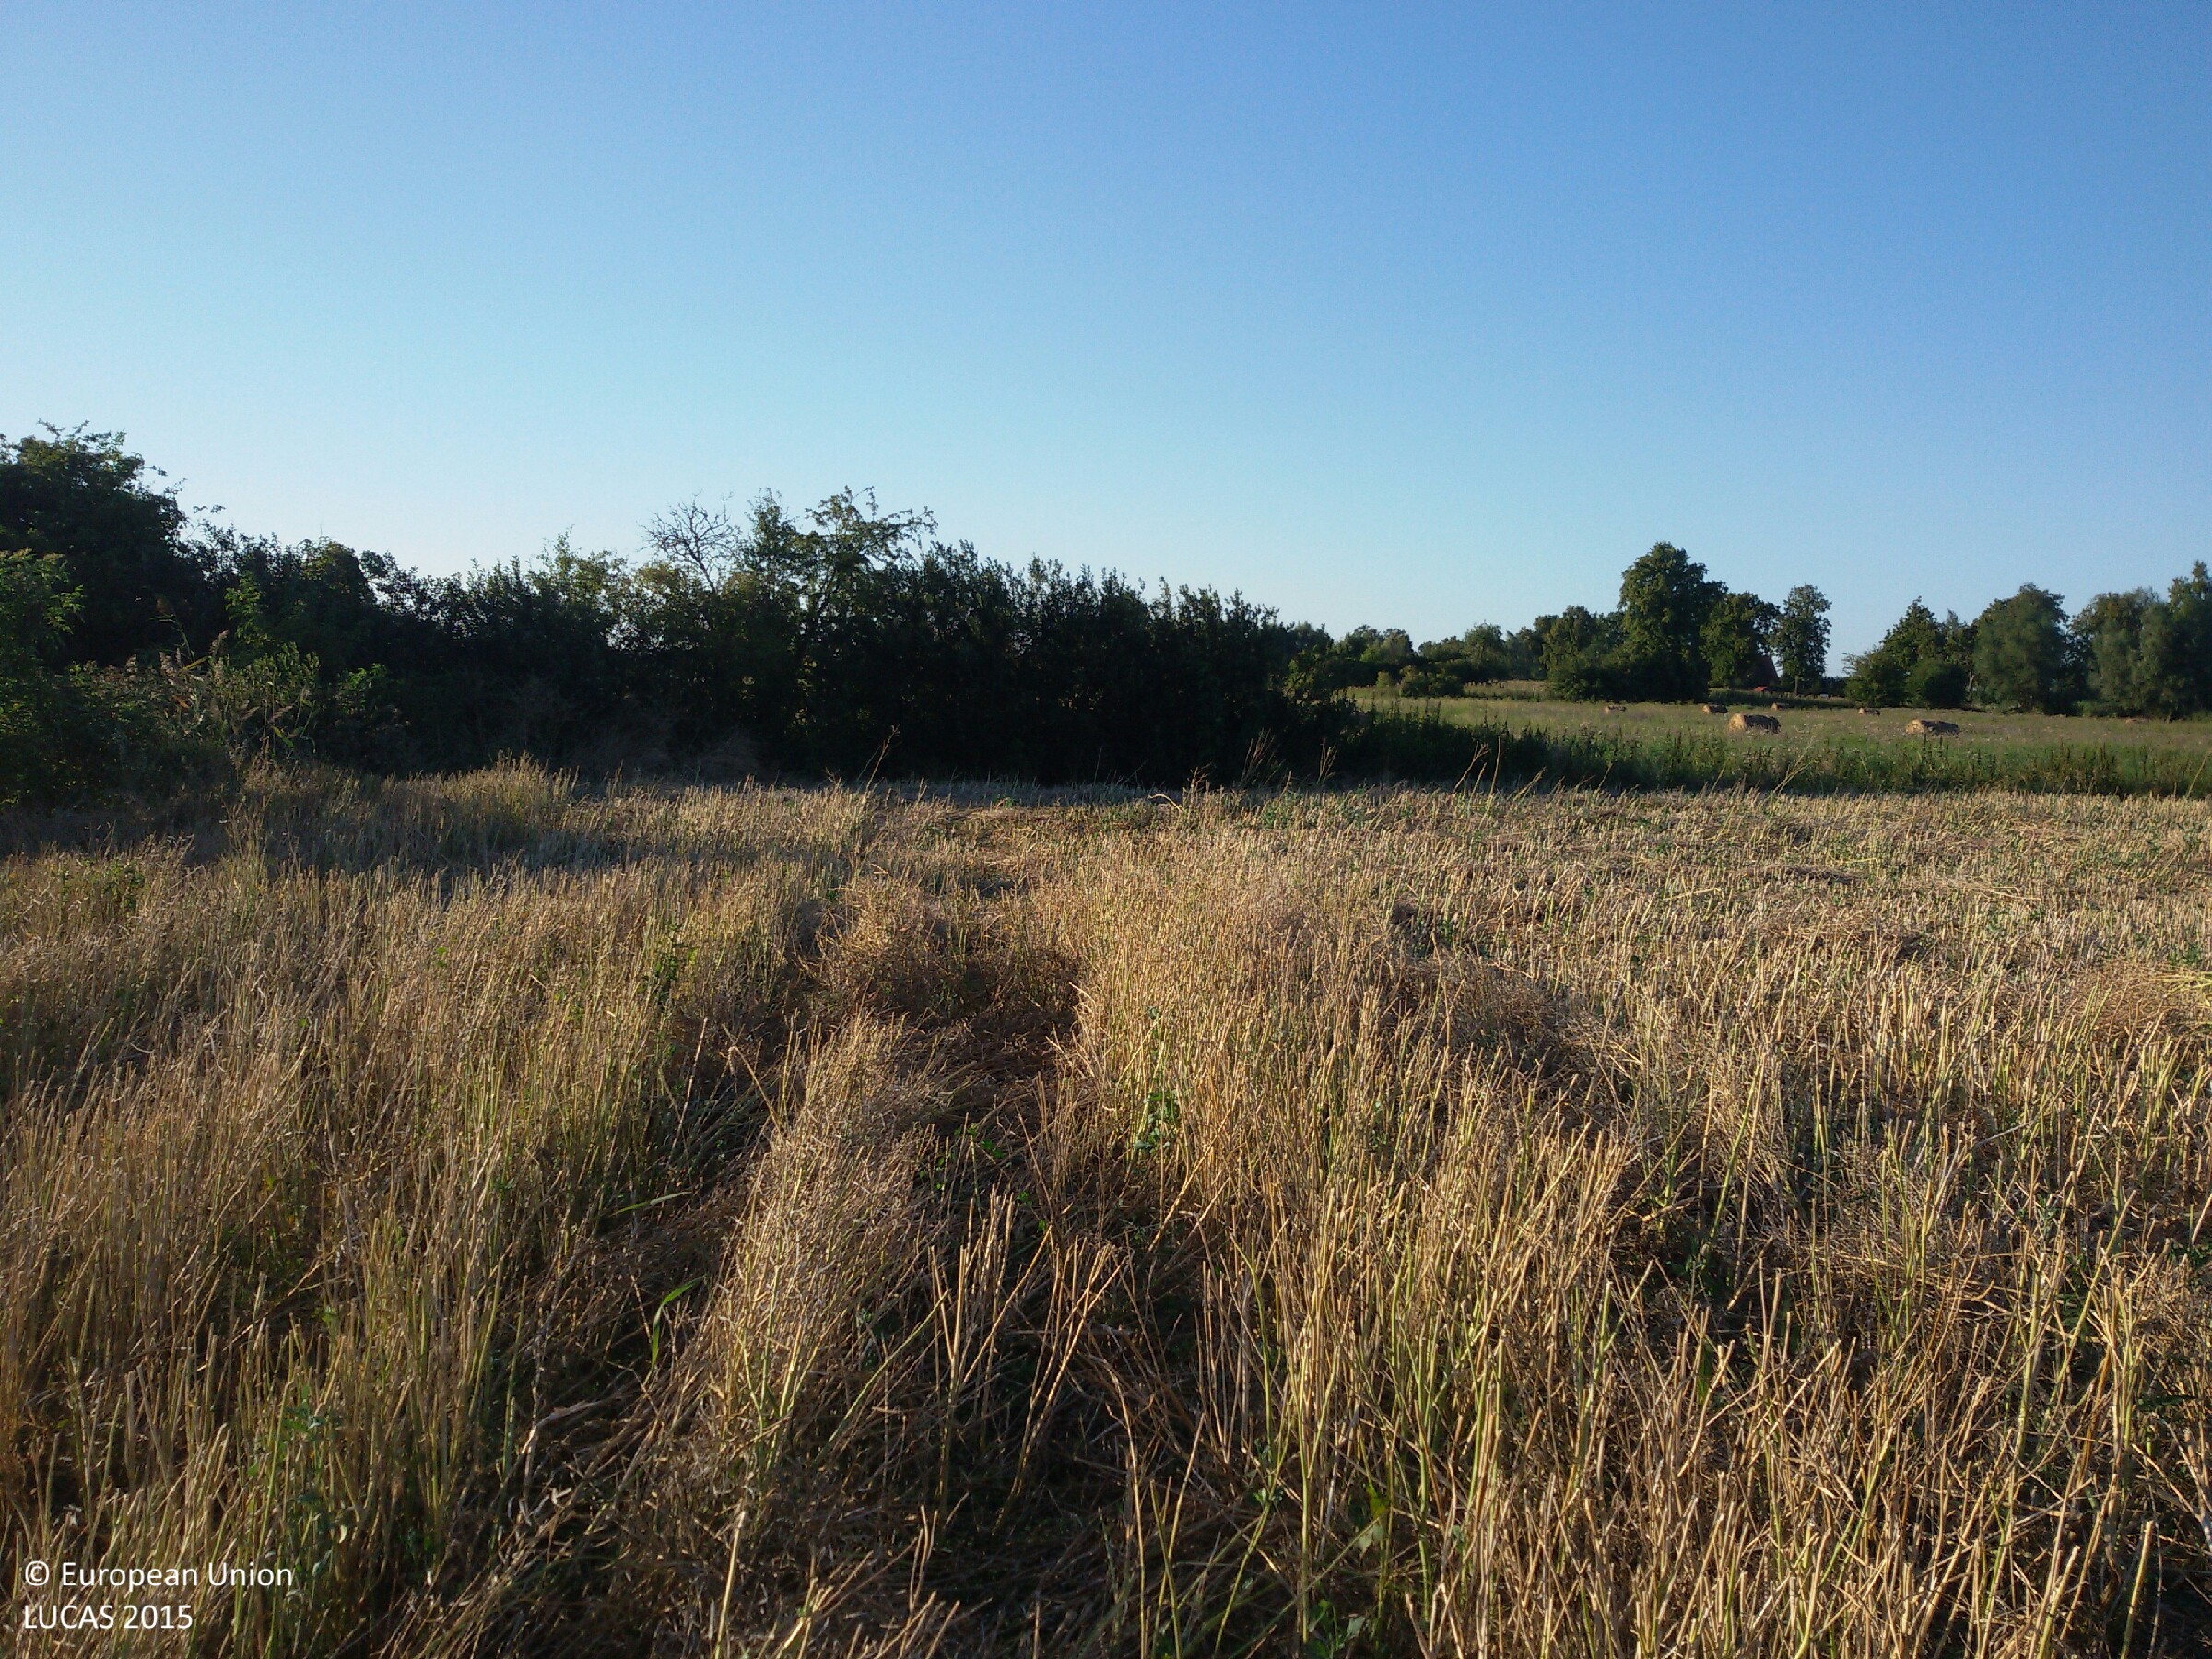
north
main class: Cropland
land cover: Rape and turnip rape
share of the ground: 50 - 75 %
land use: Agriculture (excluding fallow land and kitchen gardens)
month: August
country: PL
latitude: 54.0527
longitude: 19.3576
